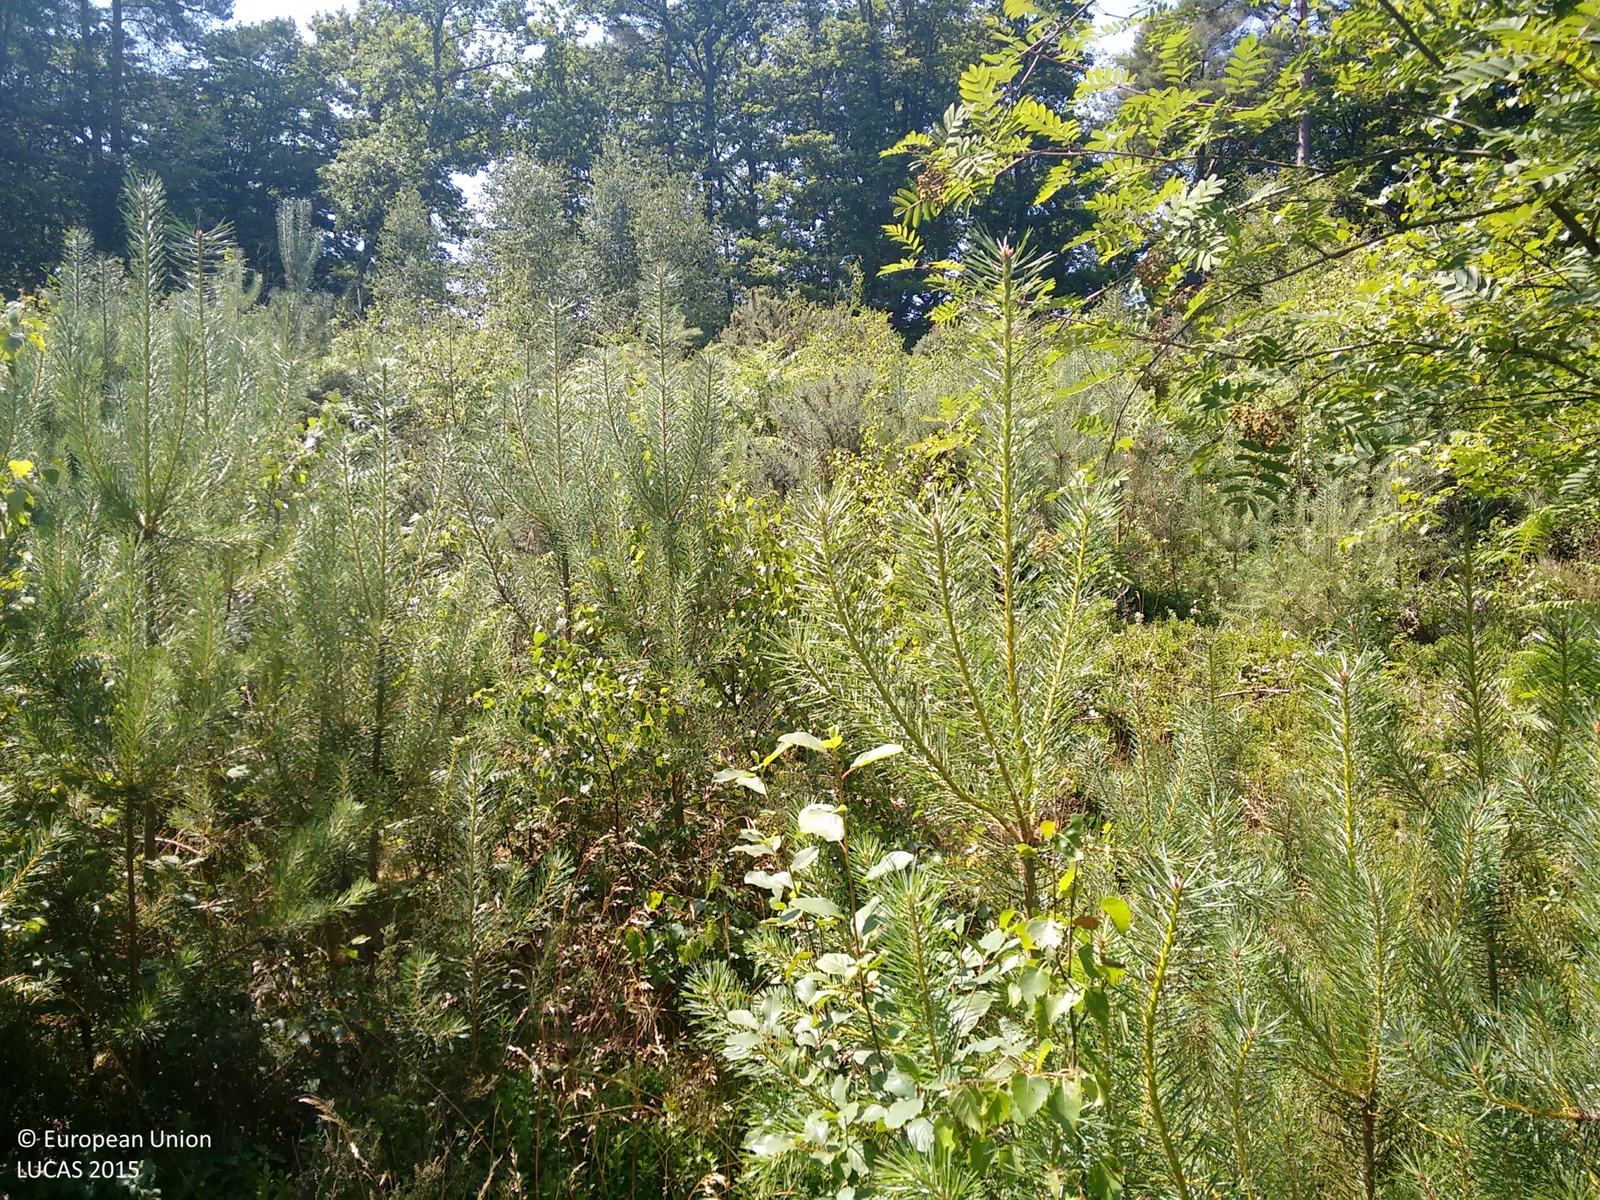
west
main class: Shrubland
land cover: Shrubland with sparse tree cover
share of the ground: > 75 %
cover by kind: shrubs 95 %, broadleaved forest trees 5 %
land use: Forestry
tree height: > 5 m
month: July
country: GB
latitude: 51.1905
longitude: -0.4400
